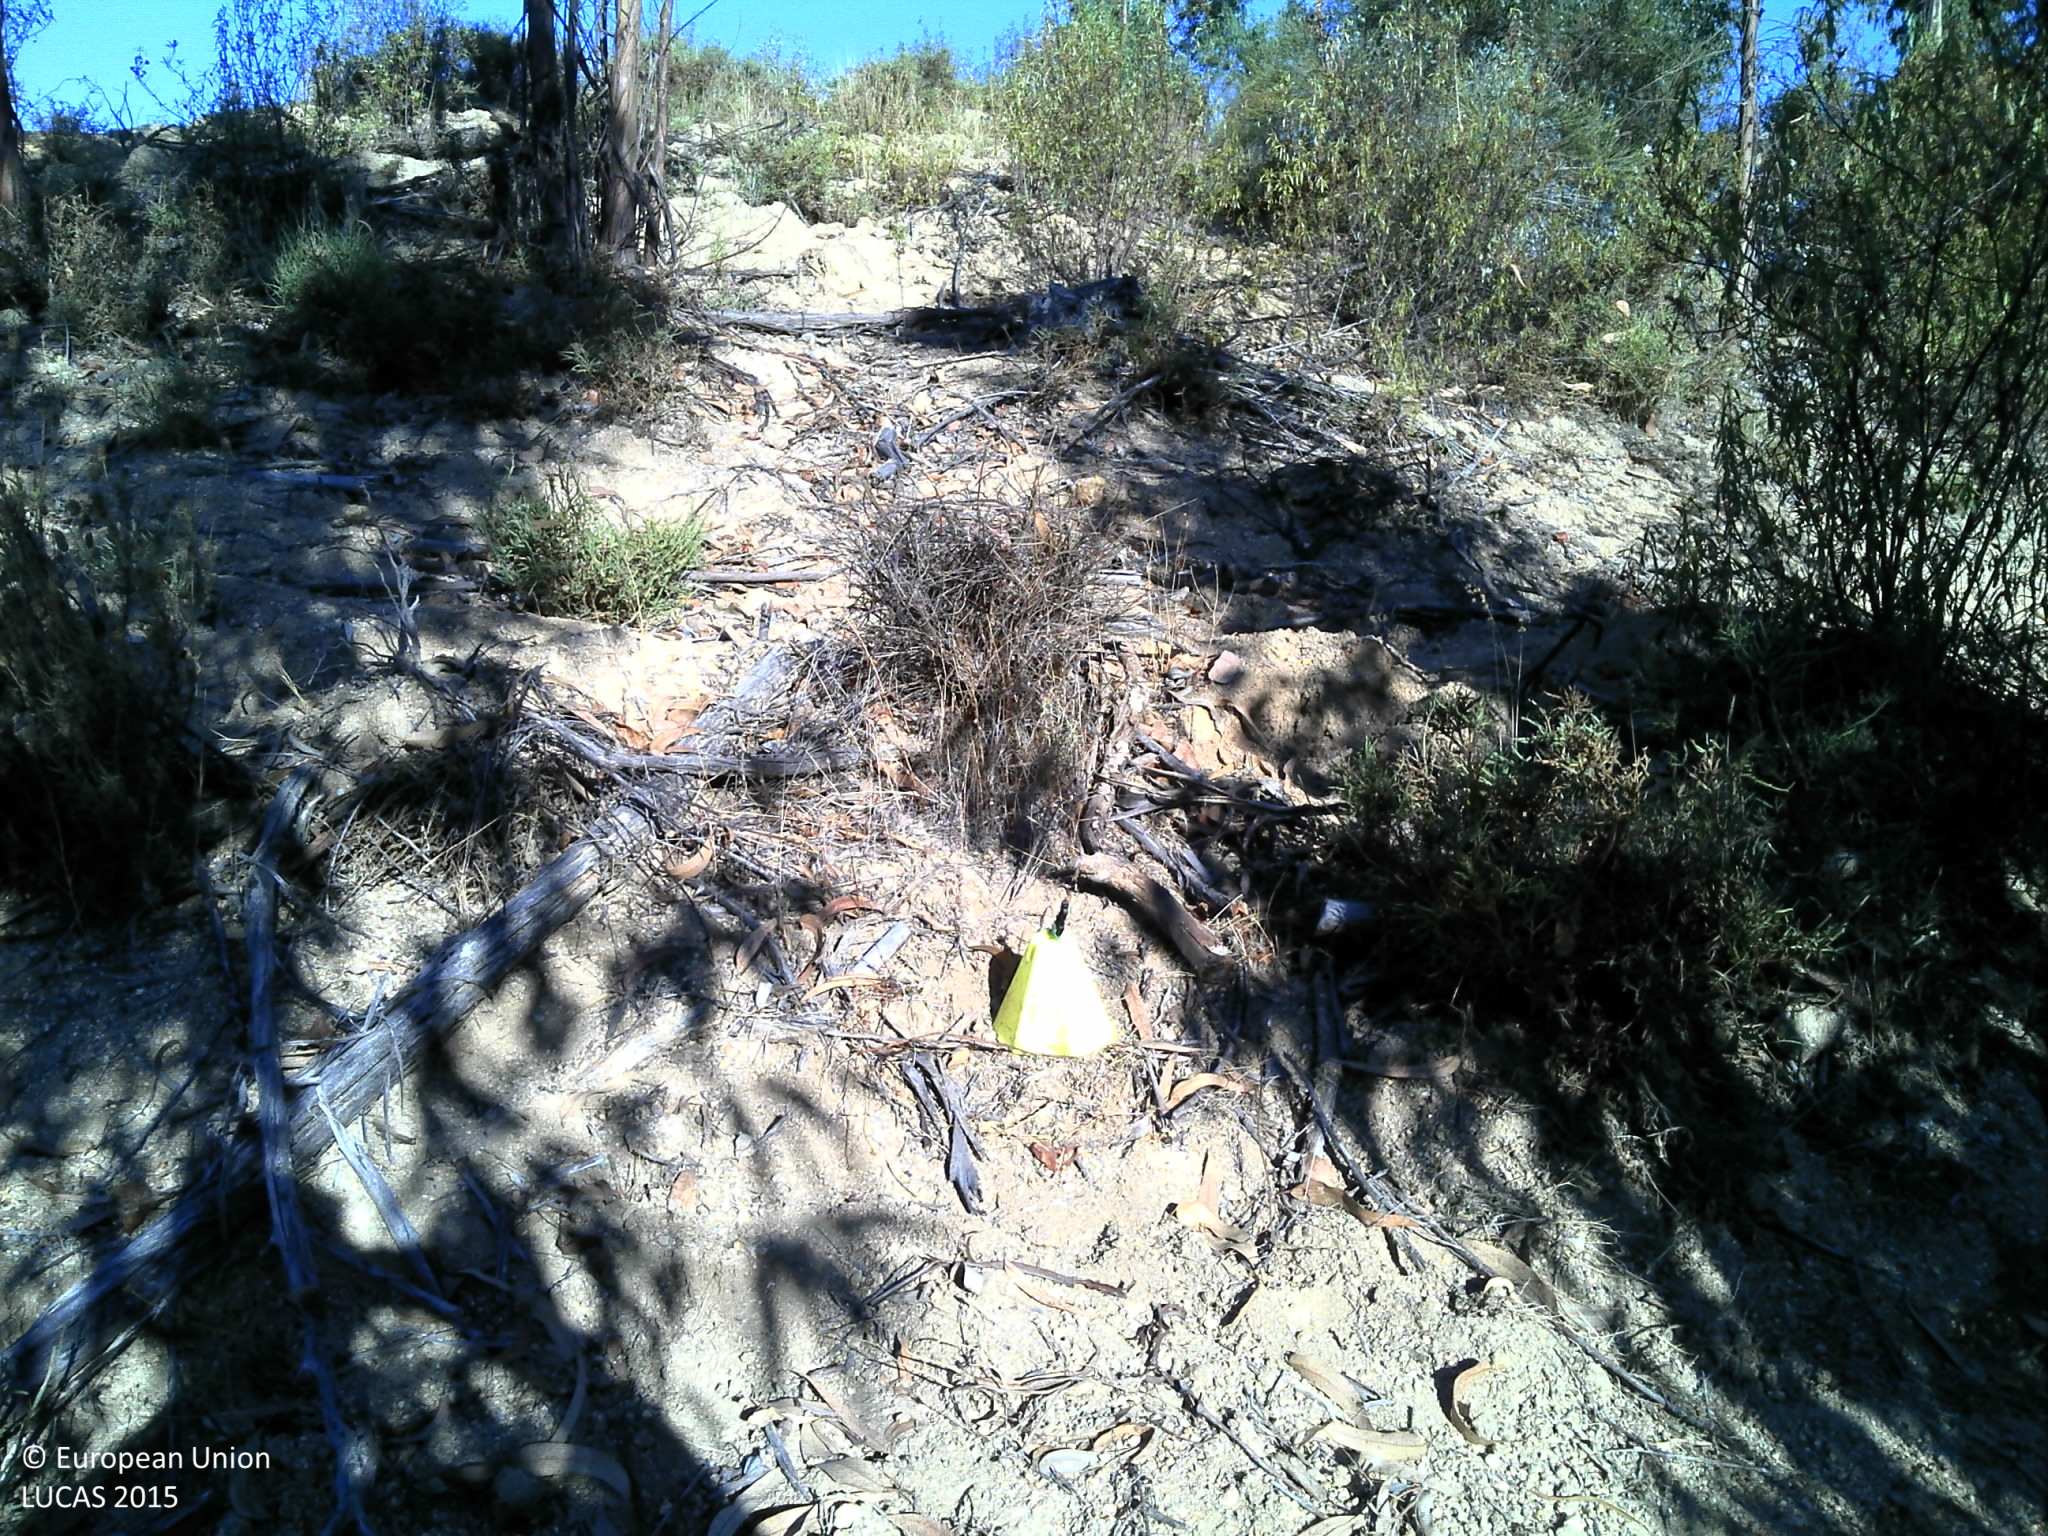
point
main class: Woodland
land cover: Broadleaved woodland
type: broadleaved evergreen forest
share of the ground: 10 - 25 %
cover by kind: unconsolidated bare surface 75 %, broadleaved forest trees 10 %, herbaceous plants 10 %, shrubs 5 %
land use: Forestry
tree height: > 5 m
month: August
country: PT
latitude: 39.5173
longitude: -7.7690
